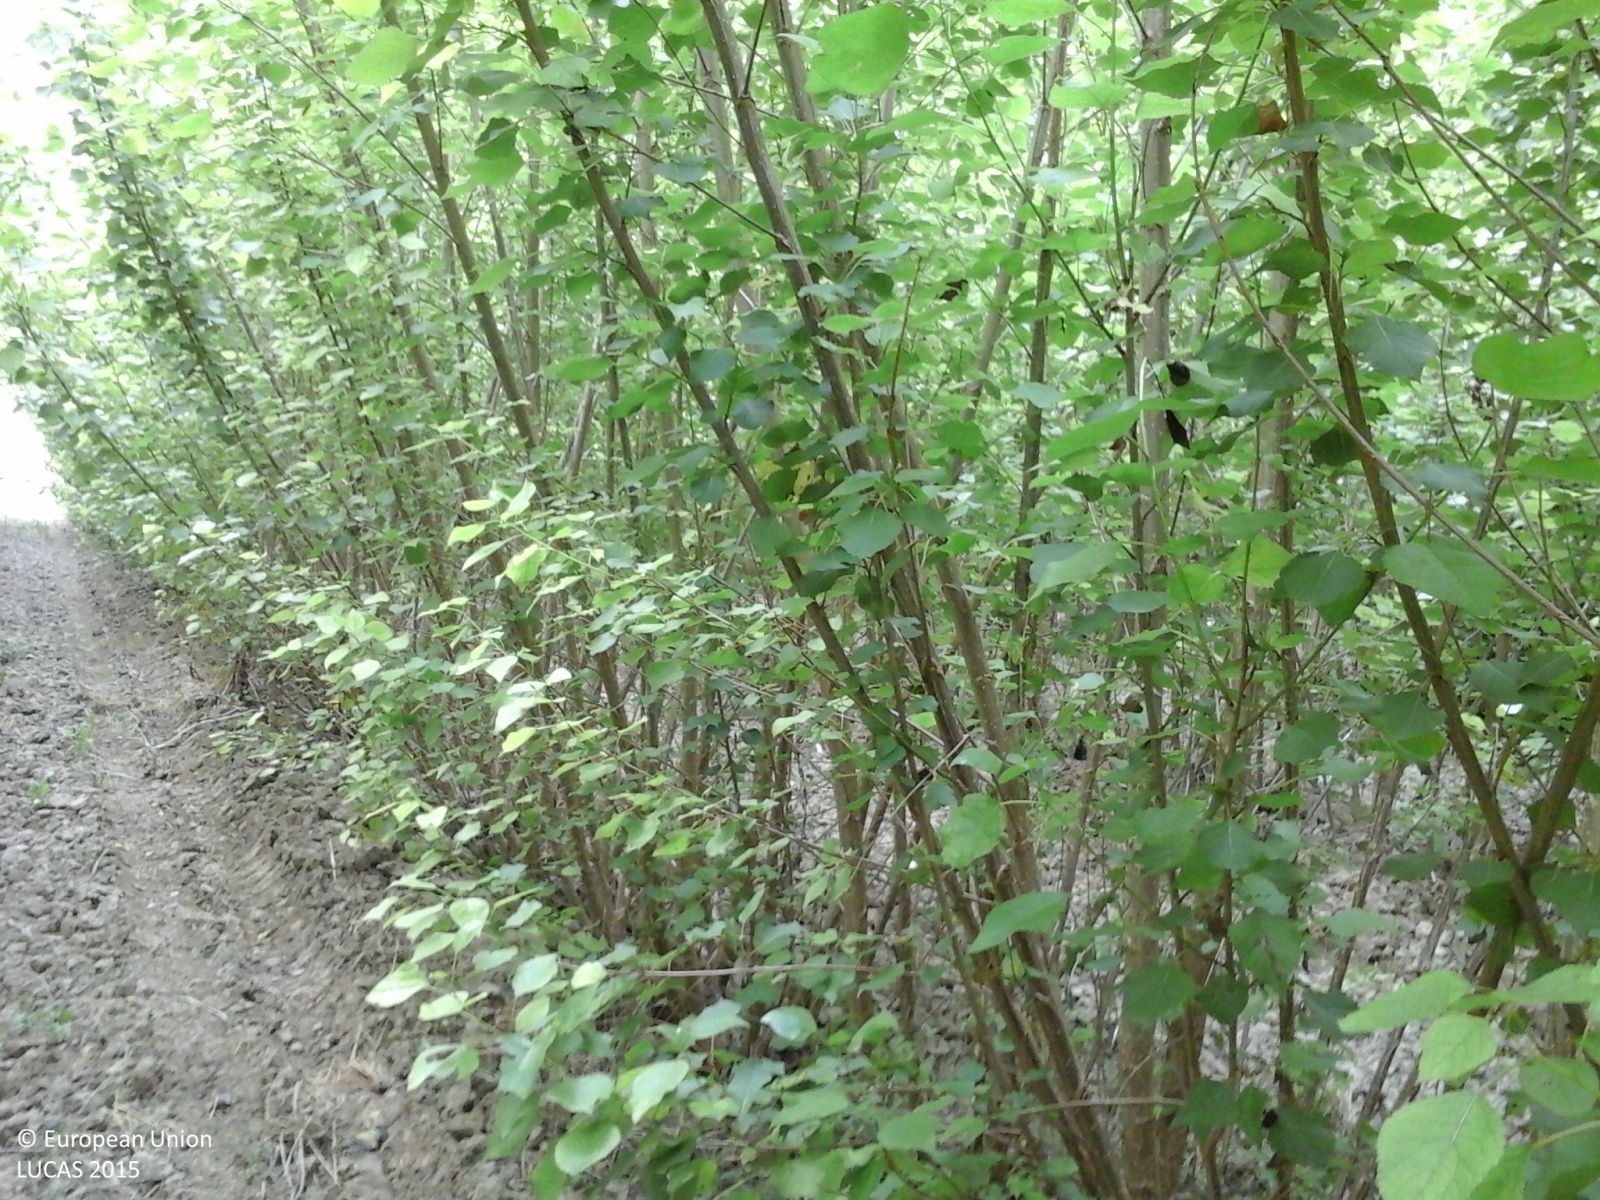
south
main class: Woodland
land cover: Broadleaved woodland
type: non-riverine alder, birch or aspen forest
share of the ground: > 75 %
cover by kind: broadleaved forest trees 100 %
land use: Forestry
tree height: < 5 m
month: June
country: IT
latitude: 44.8021
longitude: 11.9053
